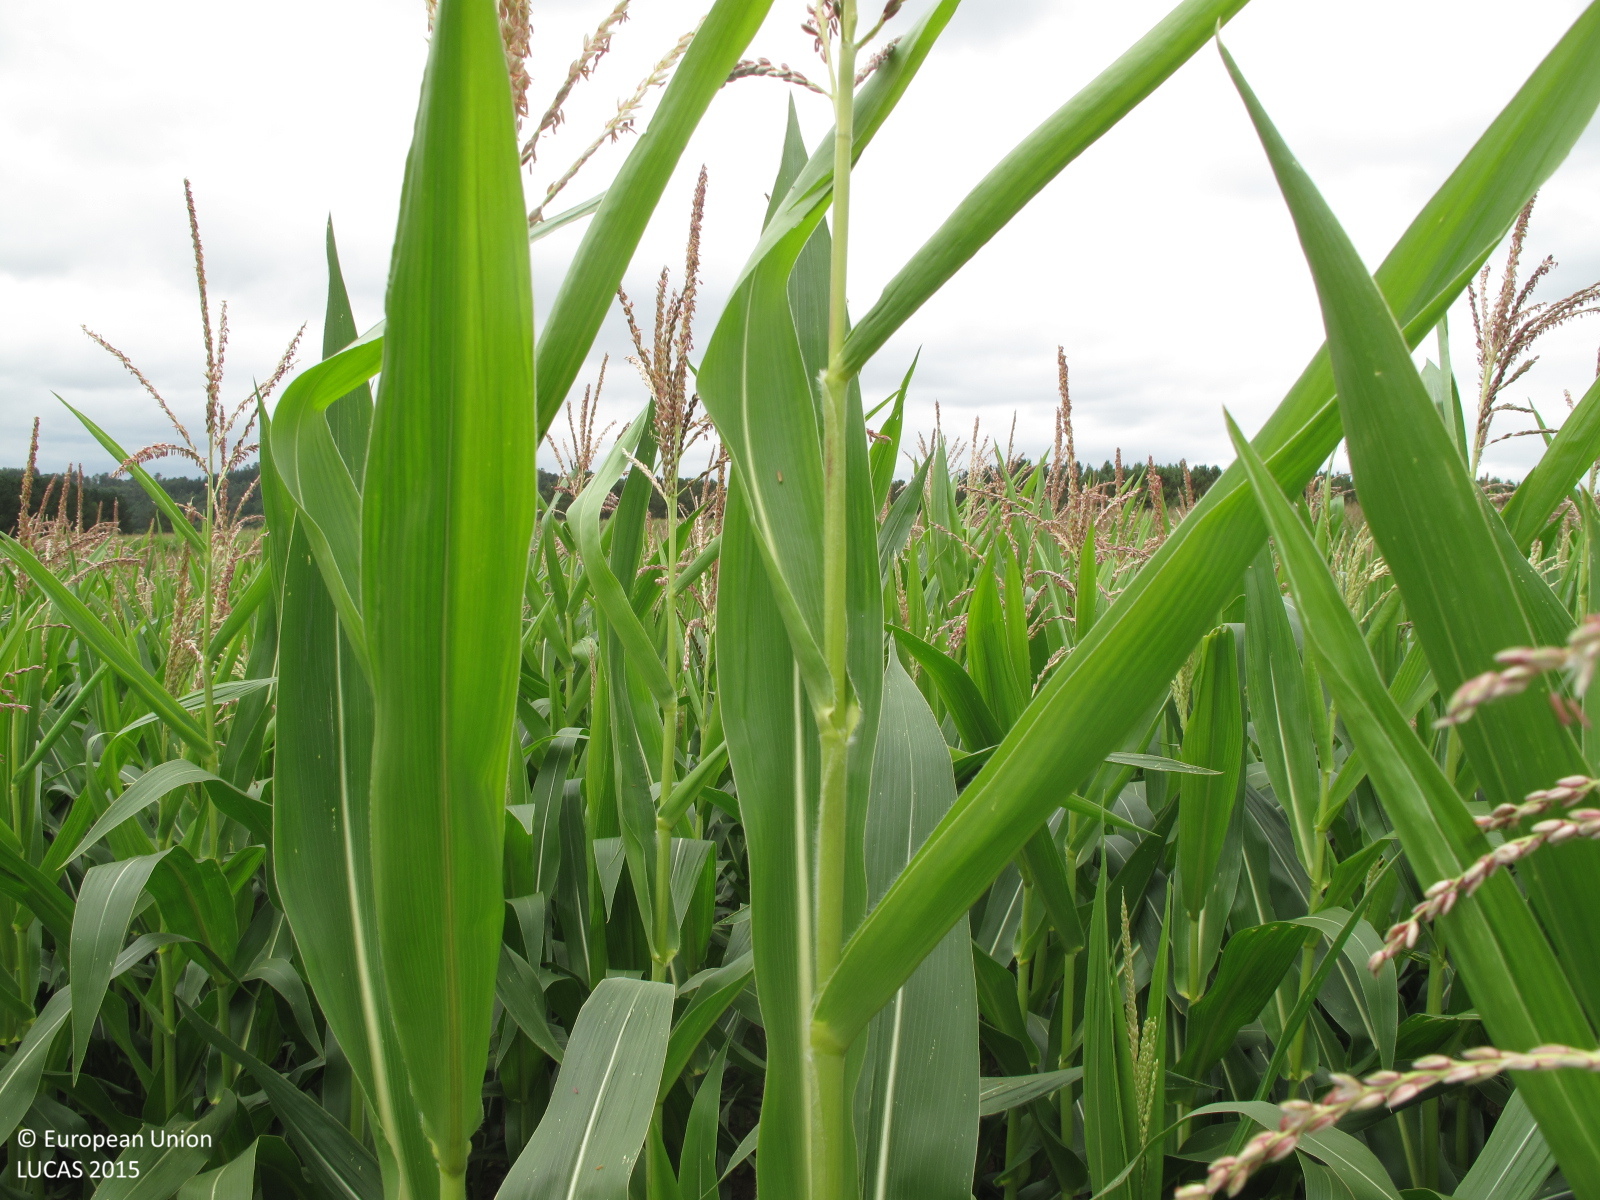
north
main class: Cropland
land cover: Maize
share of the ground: > 75 %
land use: Agriculture (excluding fallow land and kitchen gardens)
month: July
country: ES
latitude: 42.9156
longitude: -8.4655
